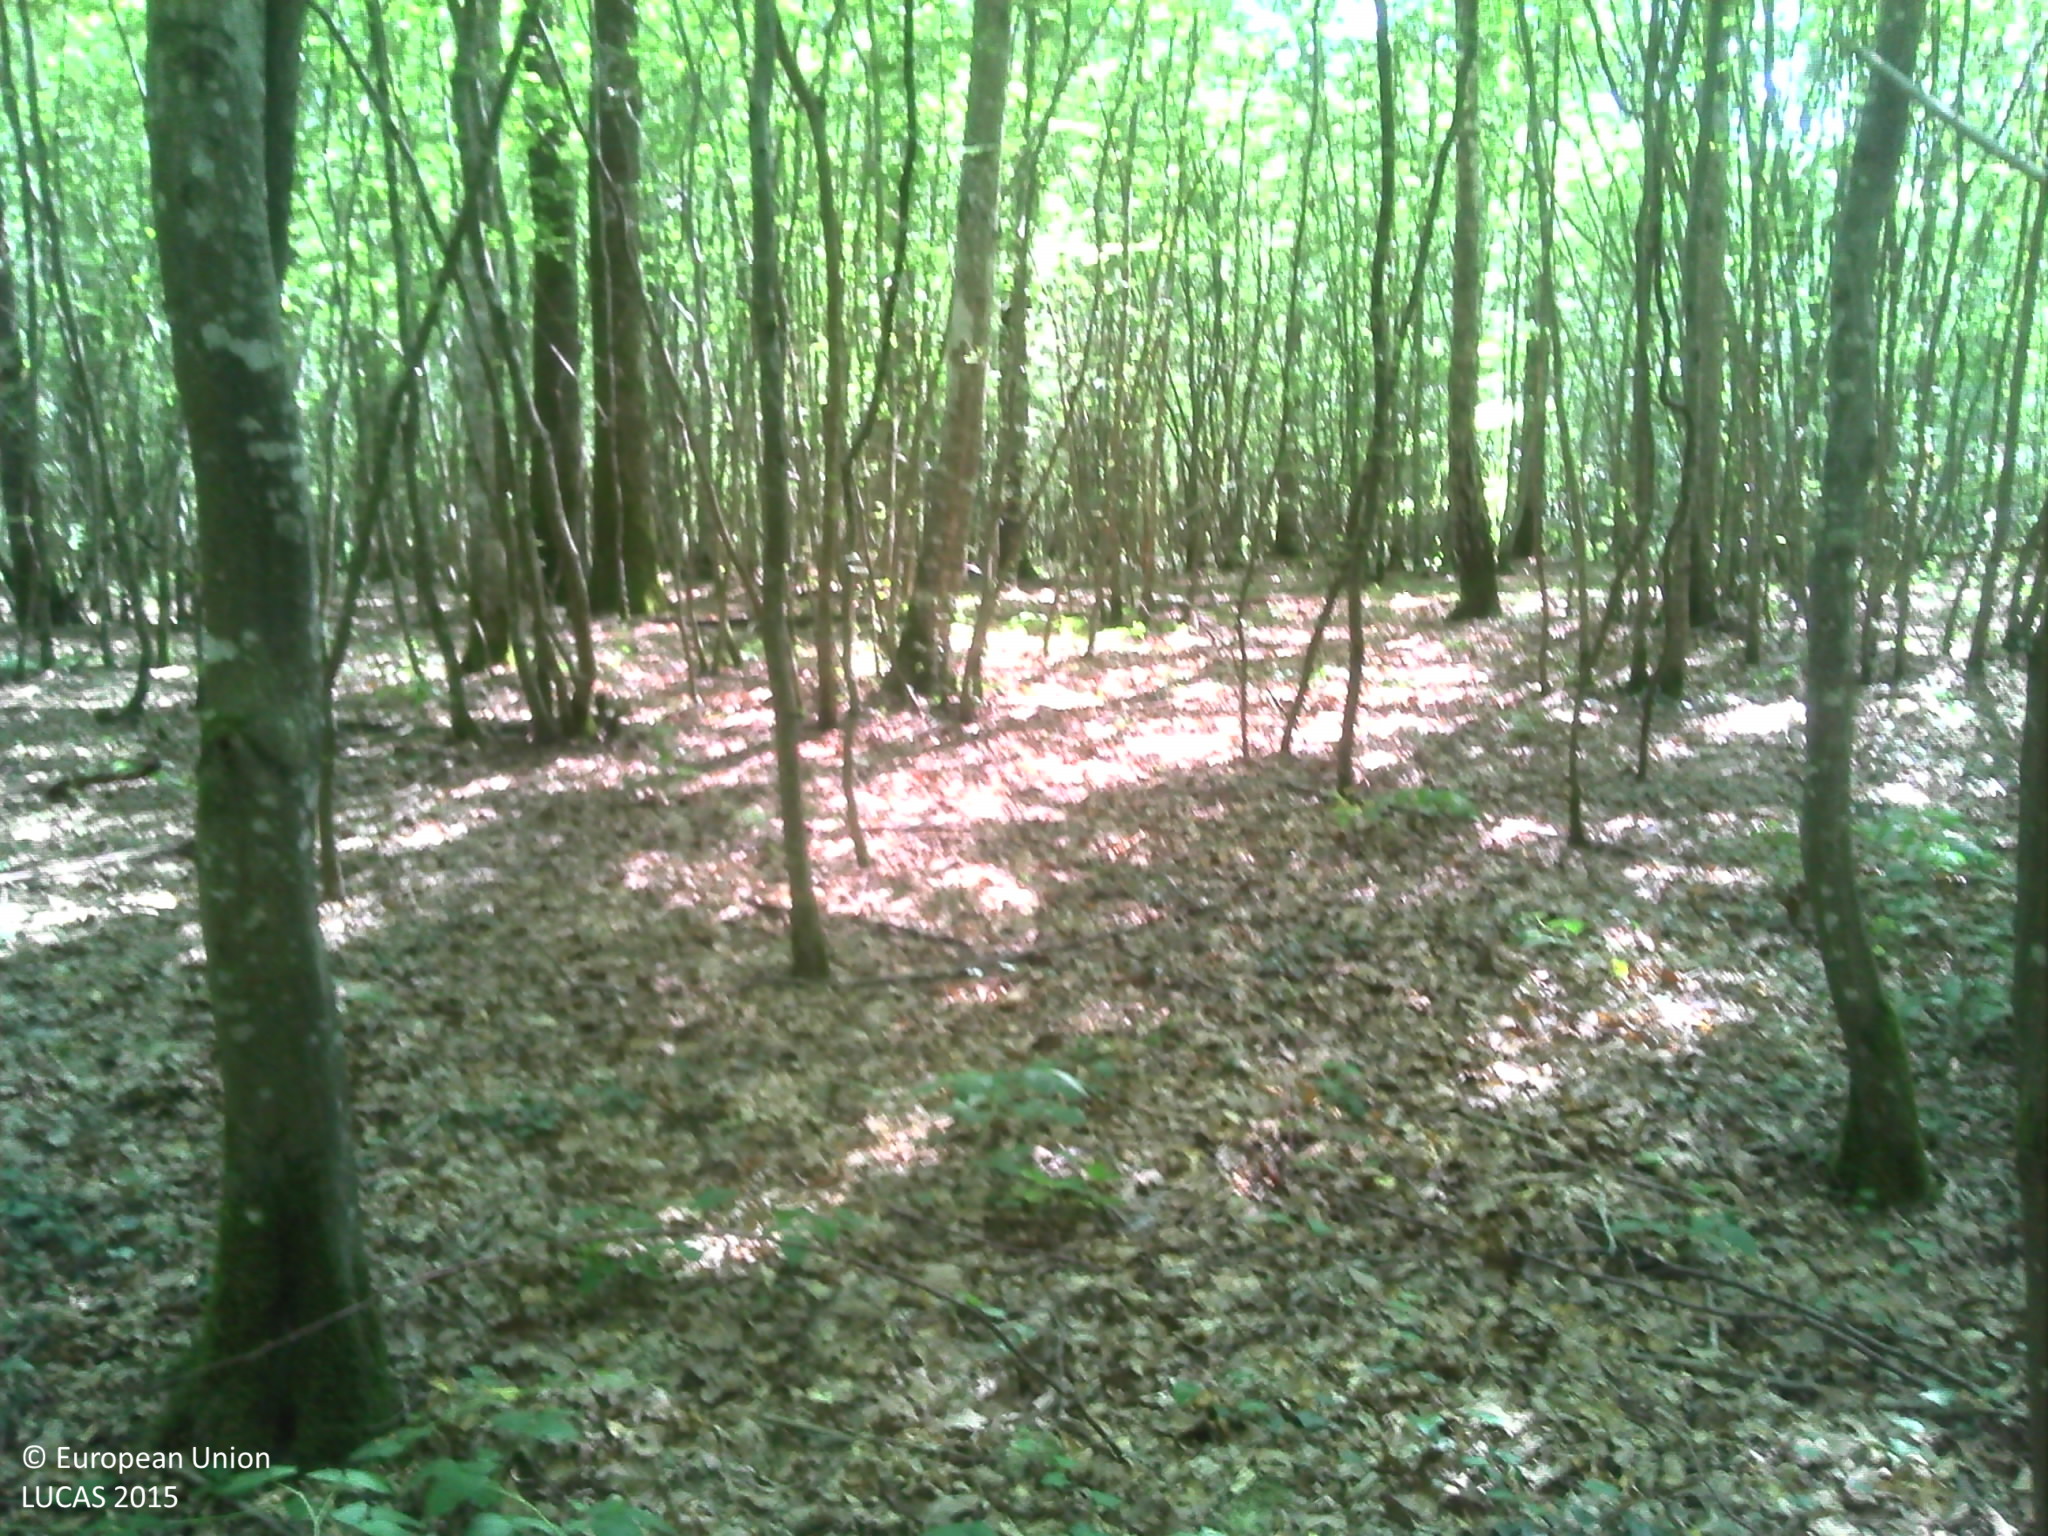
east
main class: Woodland
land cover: Broadleaved woodland
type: mesophytic deciduous forest
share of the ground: > 75 %
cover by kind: broadleaved forest trees 90 %, herbaceous plants 10 %
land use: Forestry
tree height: > 5 m
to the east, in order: Broadleaved woodland
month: July
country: FR
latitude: 46.7773
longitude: 5.0378
